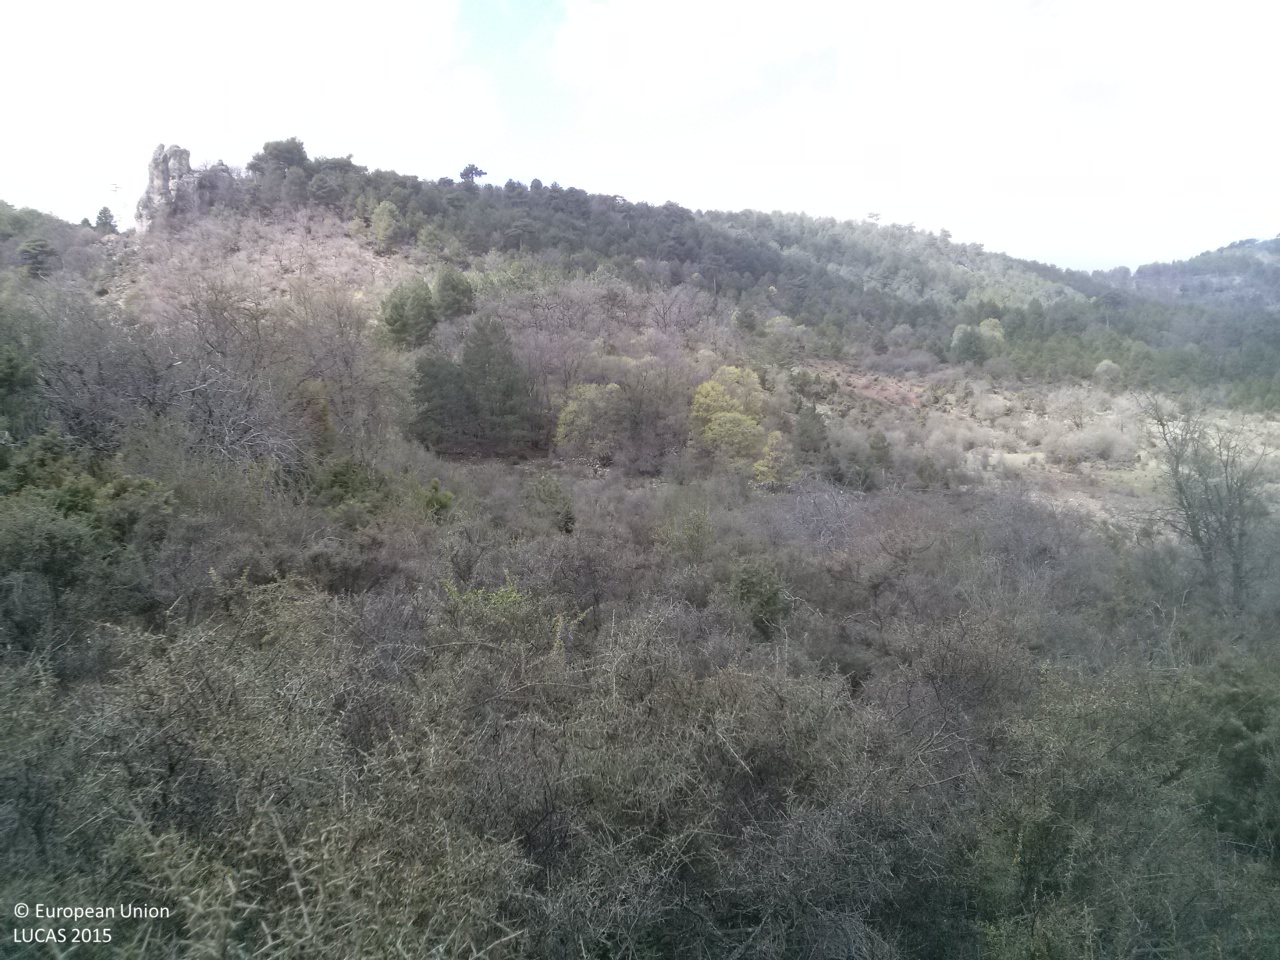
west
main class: Artificial land
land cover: Other artificial areas
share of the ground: < 10 %
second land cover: Shrubland with sparse tree cover
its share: > 75 %
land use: Electricity, gas and thermal power distribution
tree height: > 5 m
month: April
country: ES
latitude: 40.2788
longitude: -1.8356
